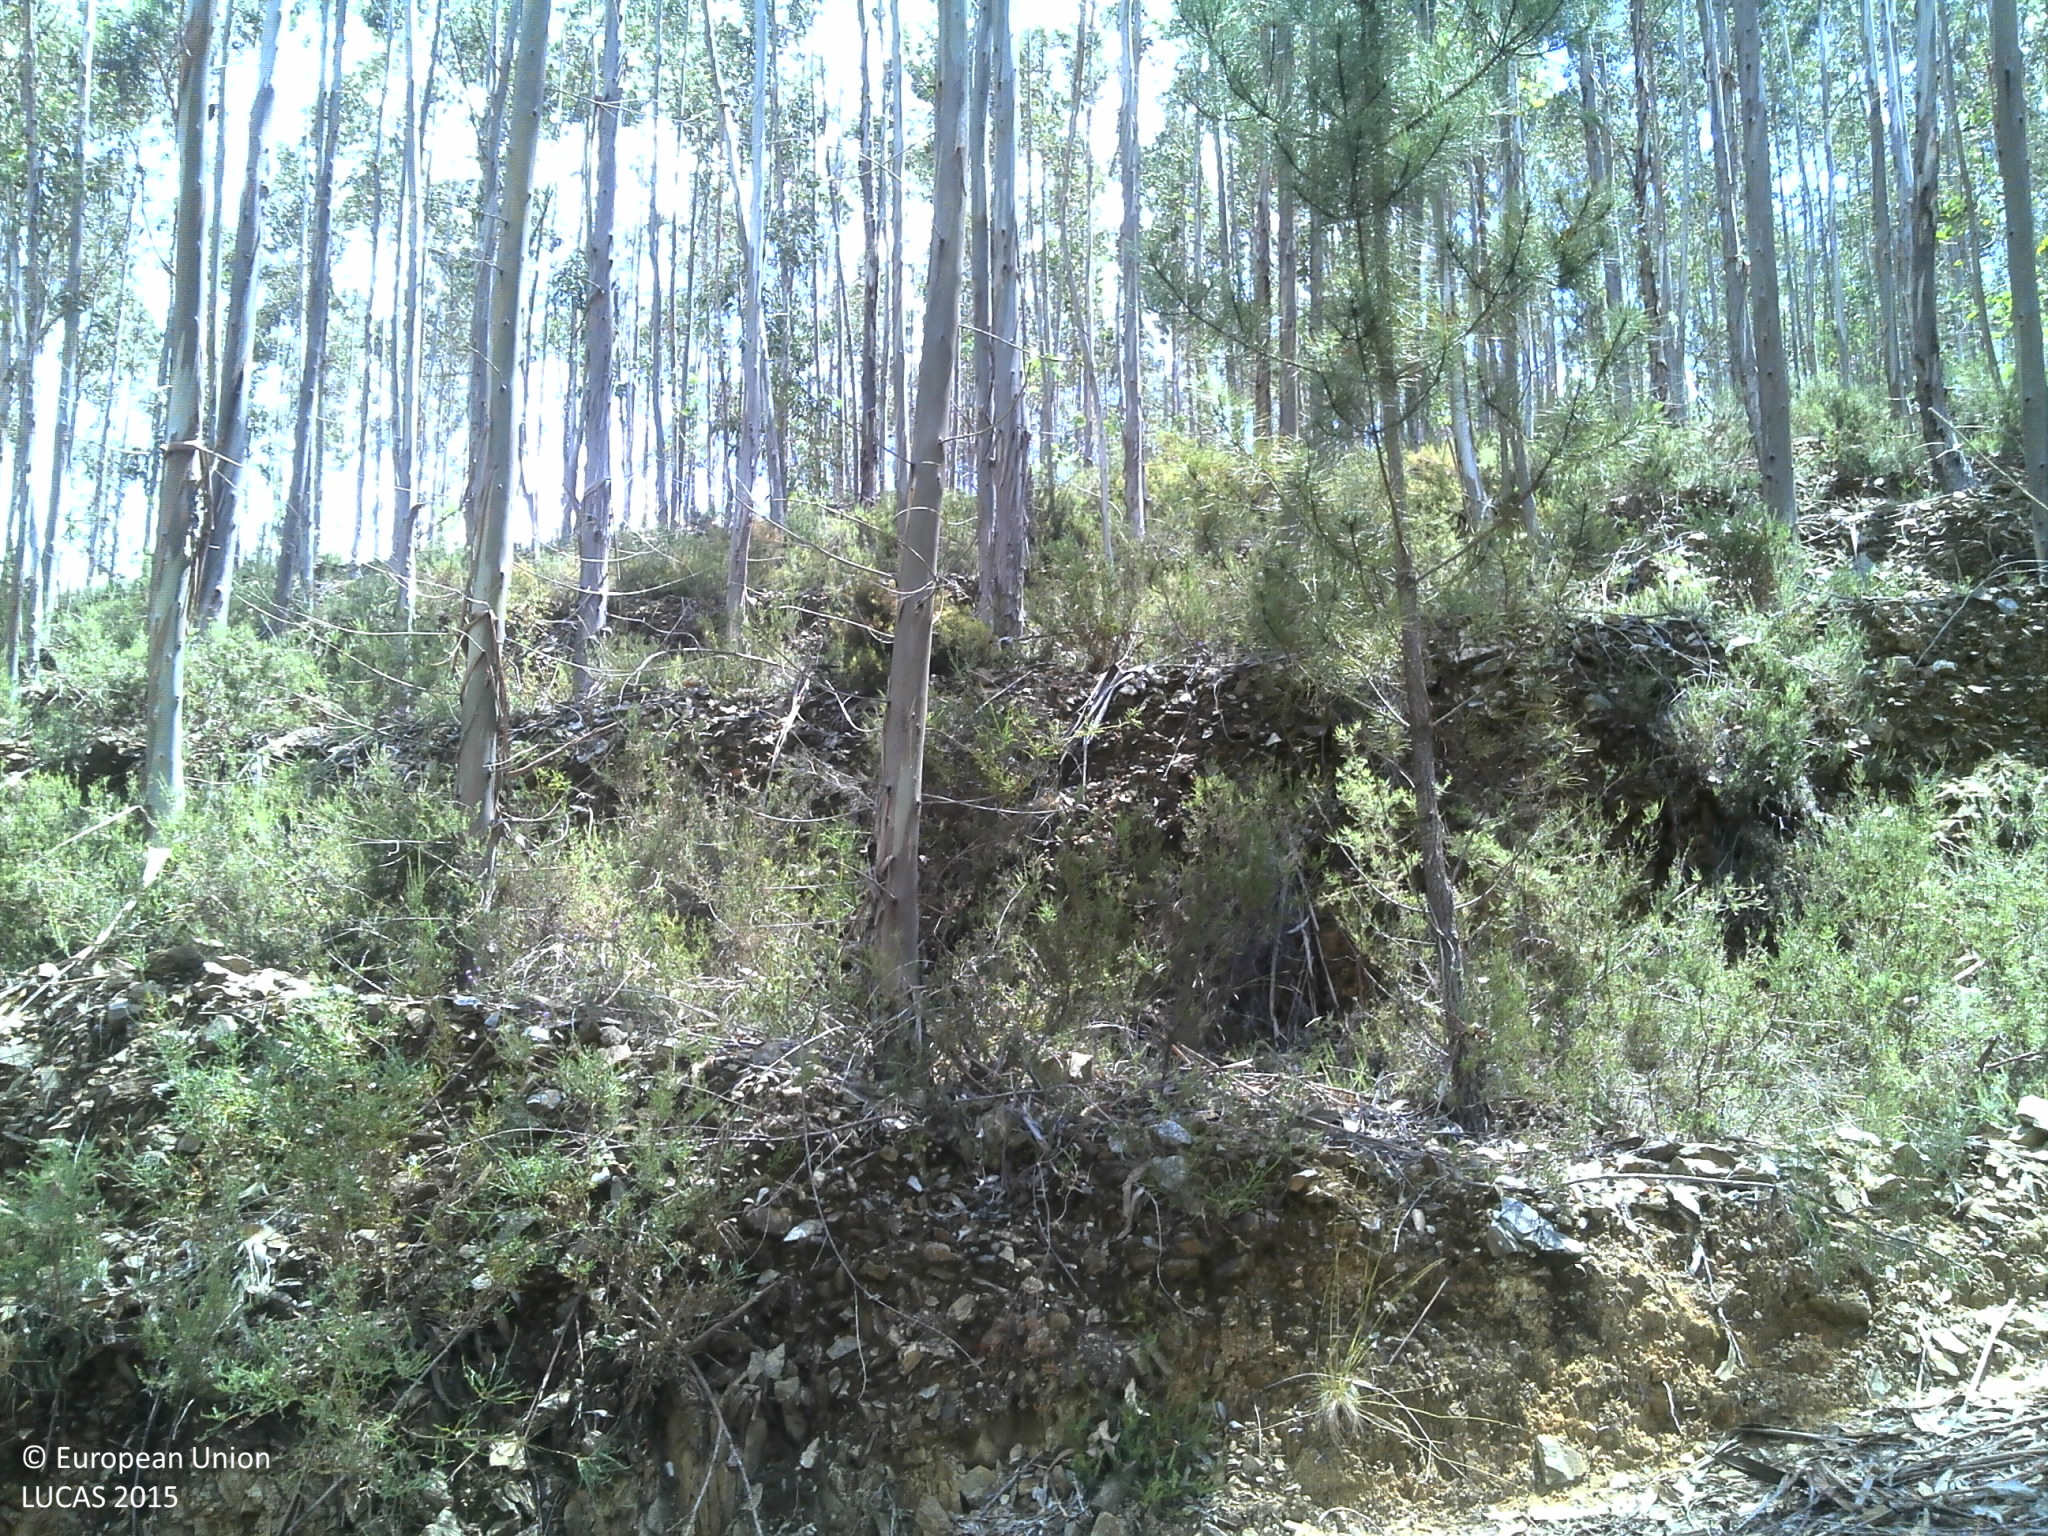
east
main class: Woodland
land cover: Broadleaved woodland
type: exotic forest
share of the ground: > 75 %
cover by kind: broadleaved forest trees 75 %, shrubs 15 %, unconsolidated bare surface 10 %
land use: Forestry
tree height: > 5 m
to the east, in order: Broadleaved woodland; Tracks; Broadleaved woodland; Tracks; Broadleaved woodland; Tracks; Shrubland with sparse tree cover; Shrubland without tree cover; Broadleaved woodland; Tracks; Broadleaved woodland; Tracks; Shrubland with sparse tree cover
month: June
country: PT
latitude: 40.9194
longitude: -8.0749
